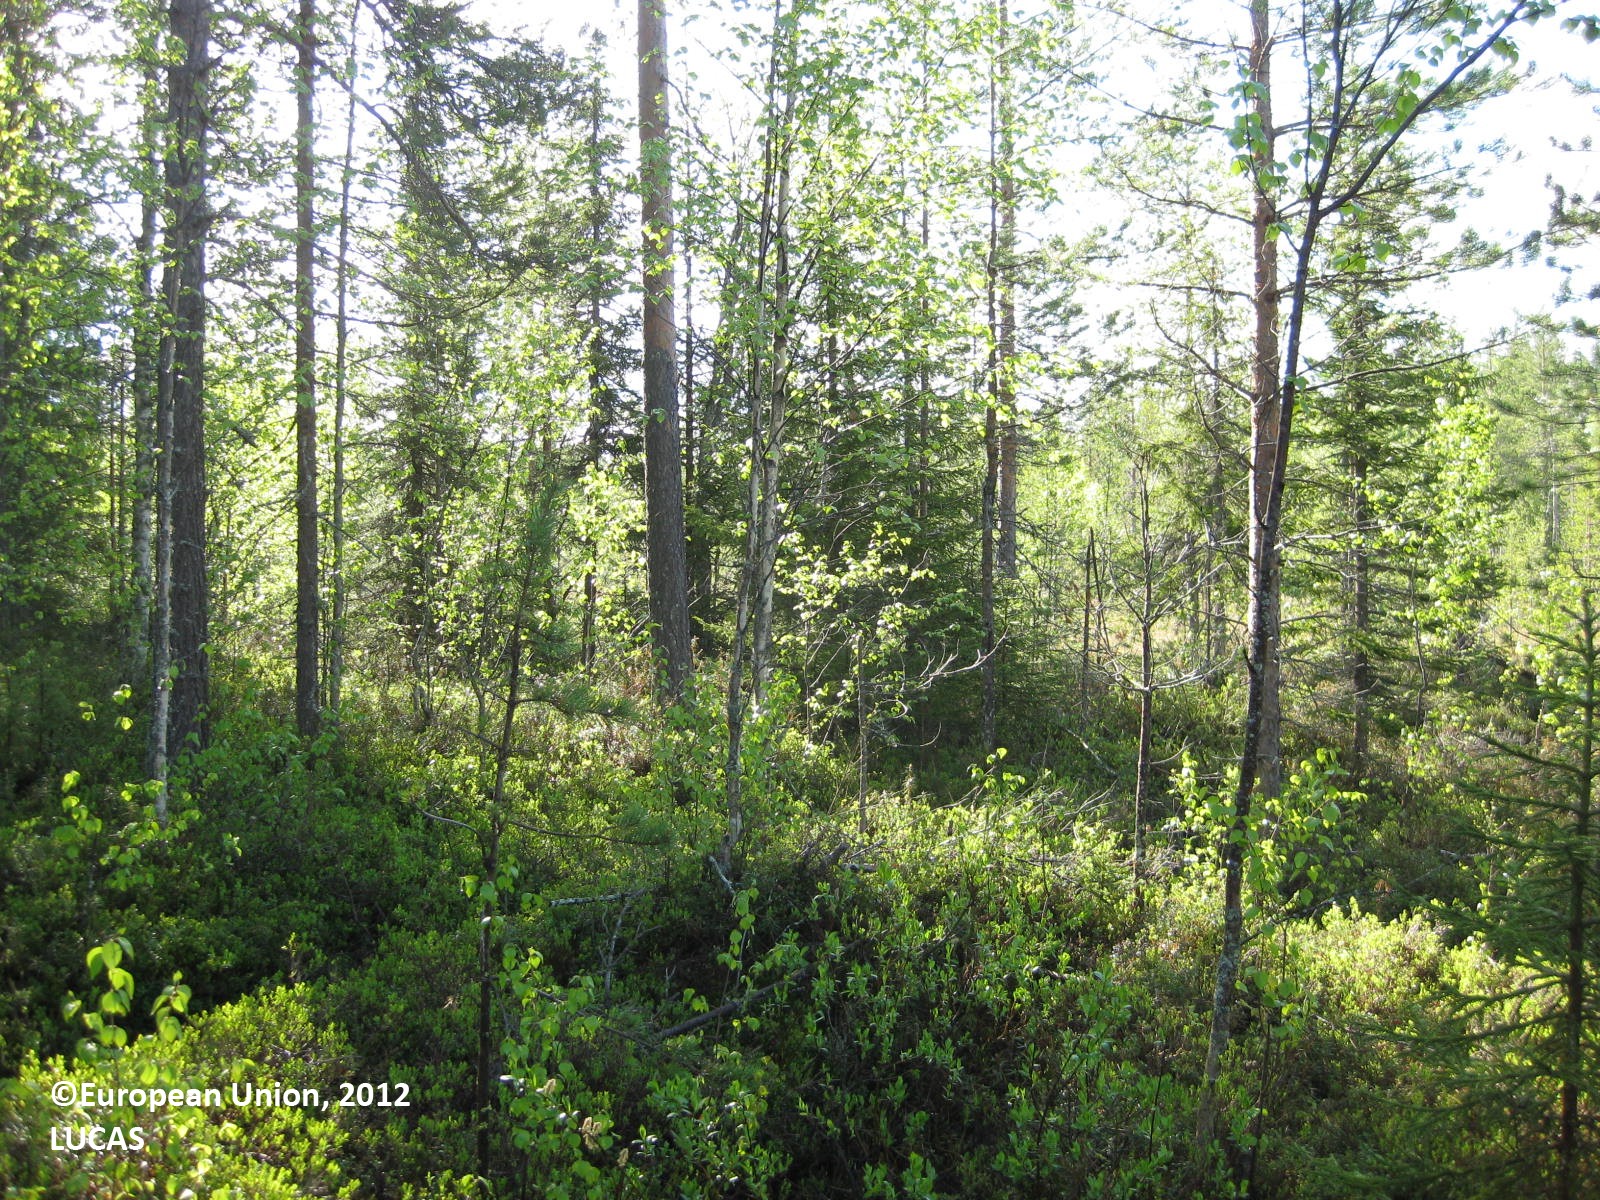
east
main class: Woodland
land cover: Pine dominated mixed woodland
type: boreal forest
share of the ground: 50 - 75 %
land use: Forestry
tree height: > 5 m
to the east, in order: Pine dominated mixed woodland; Ditches and canals; Broadleaved woodland; Pine dominated mixed woodland; Ditches and canals; Broadleaved woodland; Pine dominated mixed woodland; Ditches and canals; Pine dominated mixed woodland; Pine dominated coniferous woodland
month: June
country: FI
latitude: 65.1278
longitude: 29.5766
